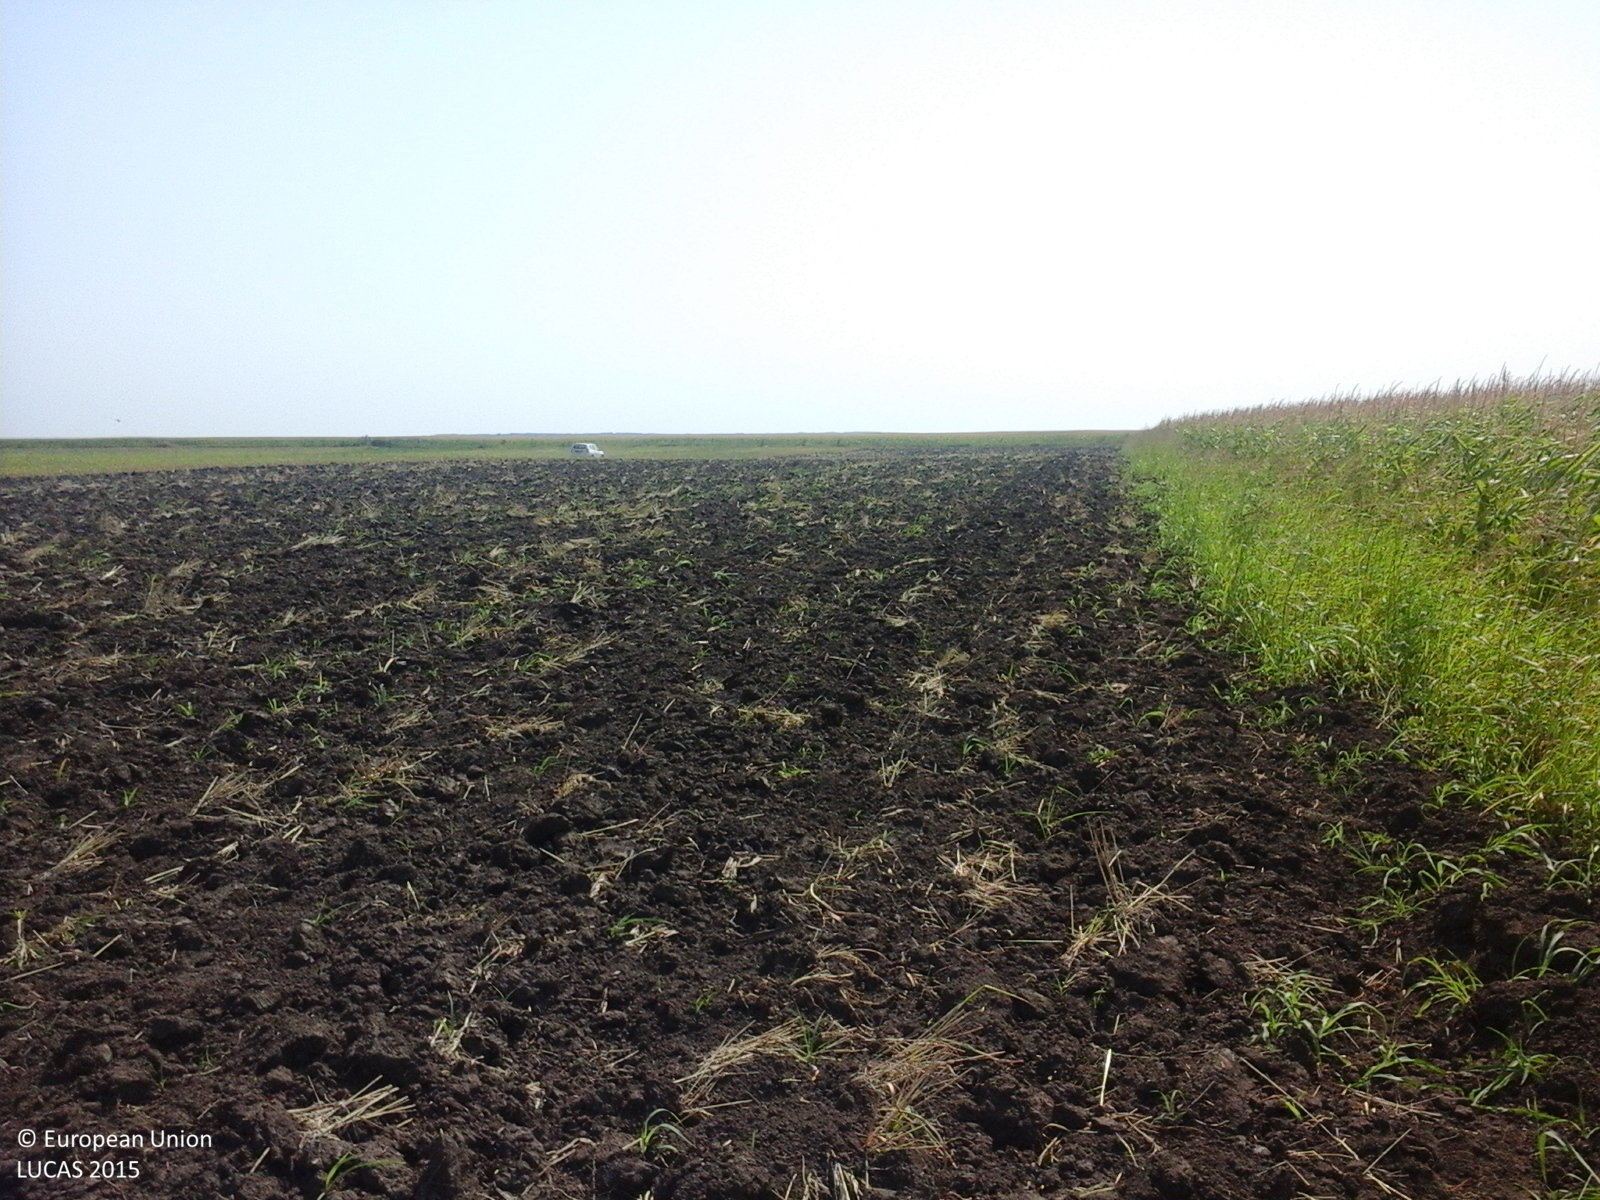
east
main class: Cropland
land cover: Maize
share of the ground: > 75 %
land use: Agriculture (excluding fallow land and kitchen gardens)
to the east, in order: Maize; Spontaneously vegetated surfaces; Ditches and canals; Spontaneously vegetated surfaces; Tracks; Grass margins; Maize
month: August
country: RO
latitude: 44.9676
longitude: 26.7227
